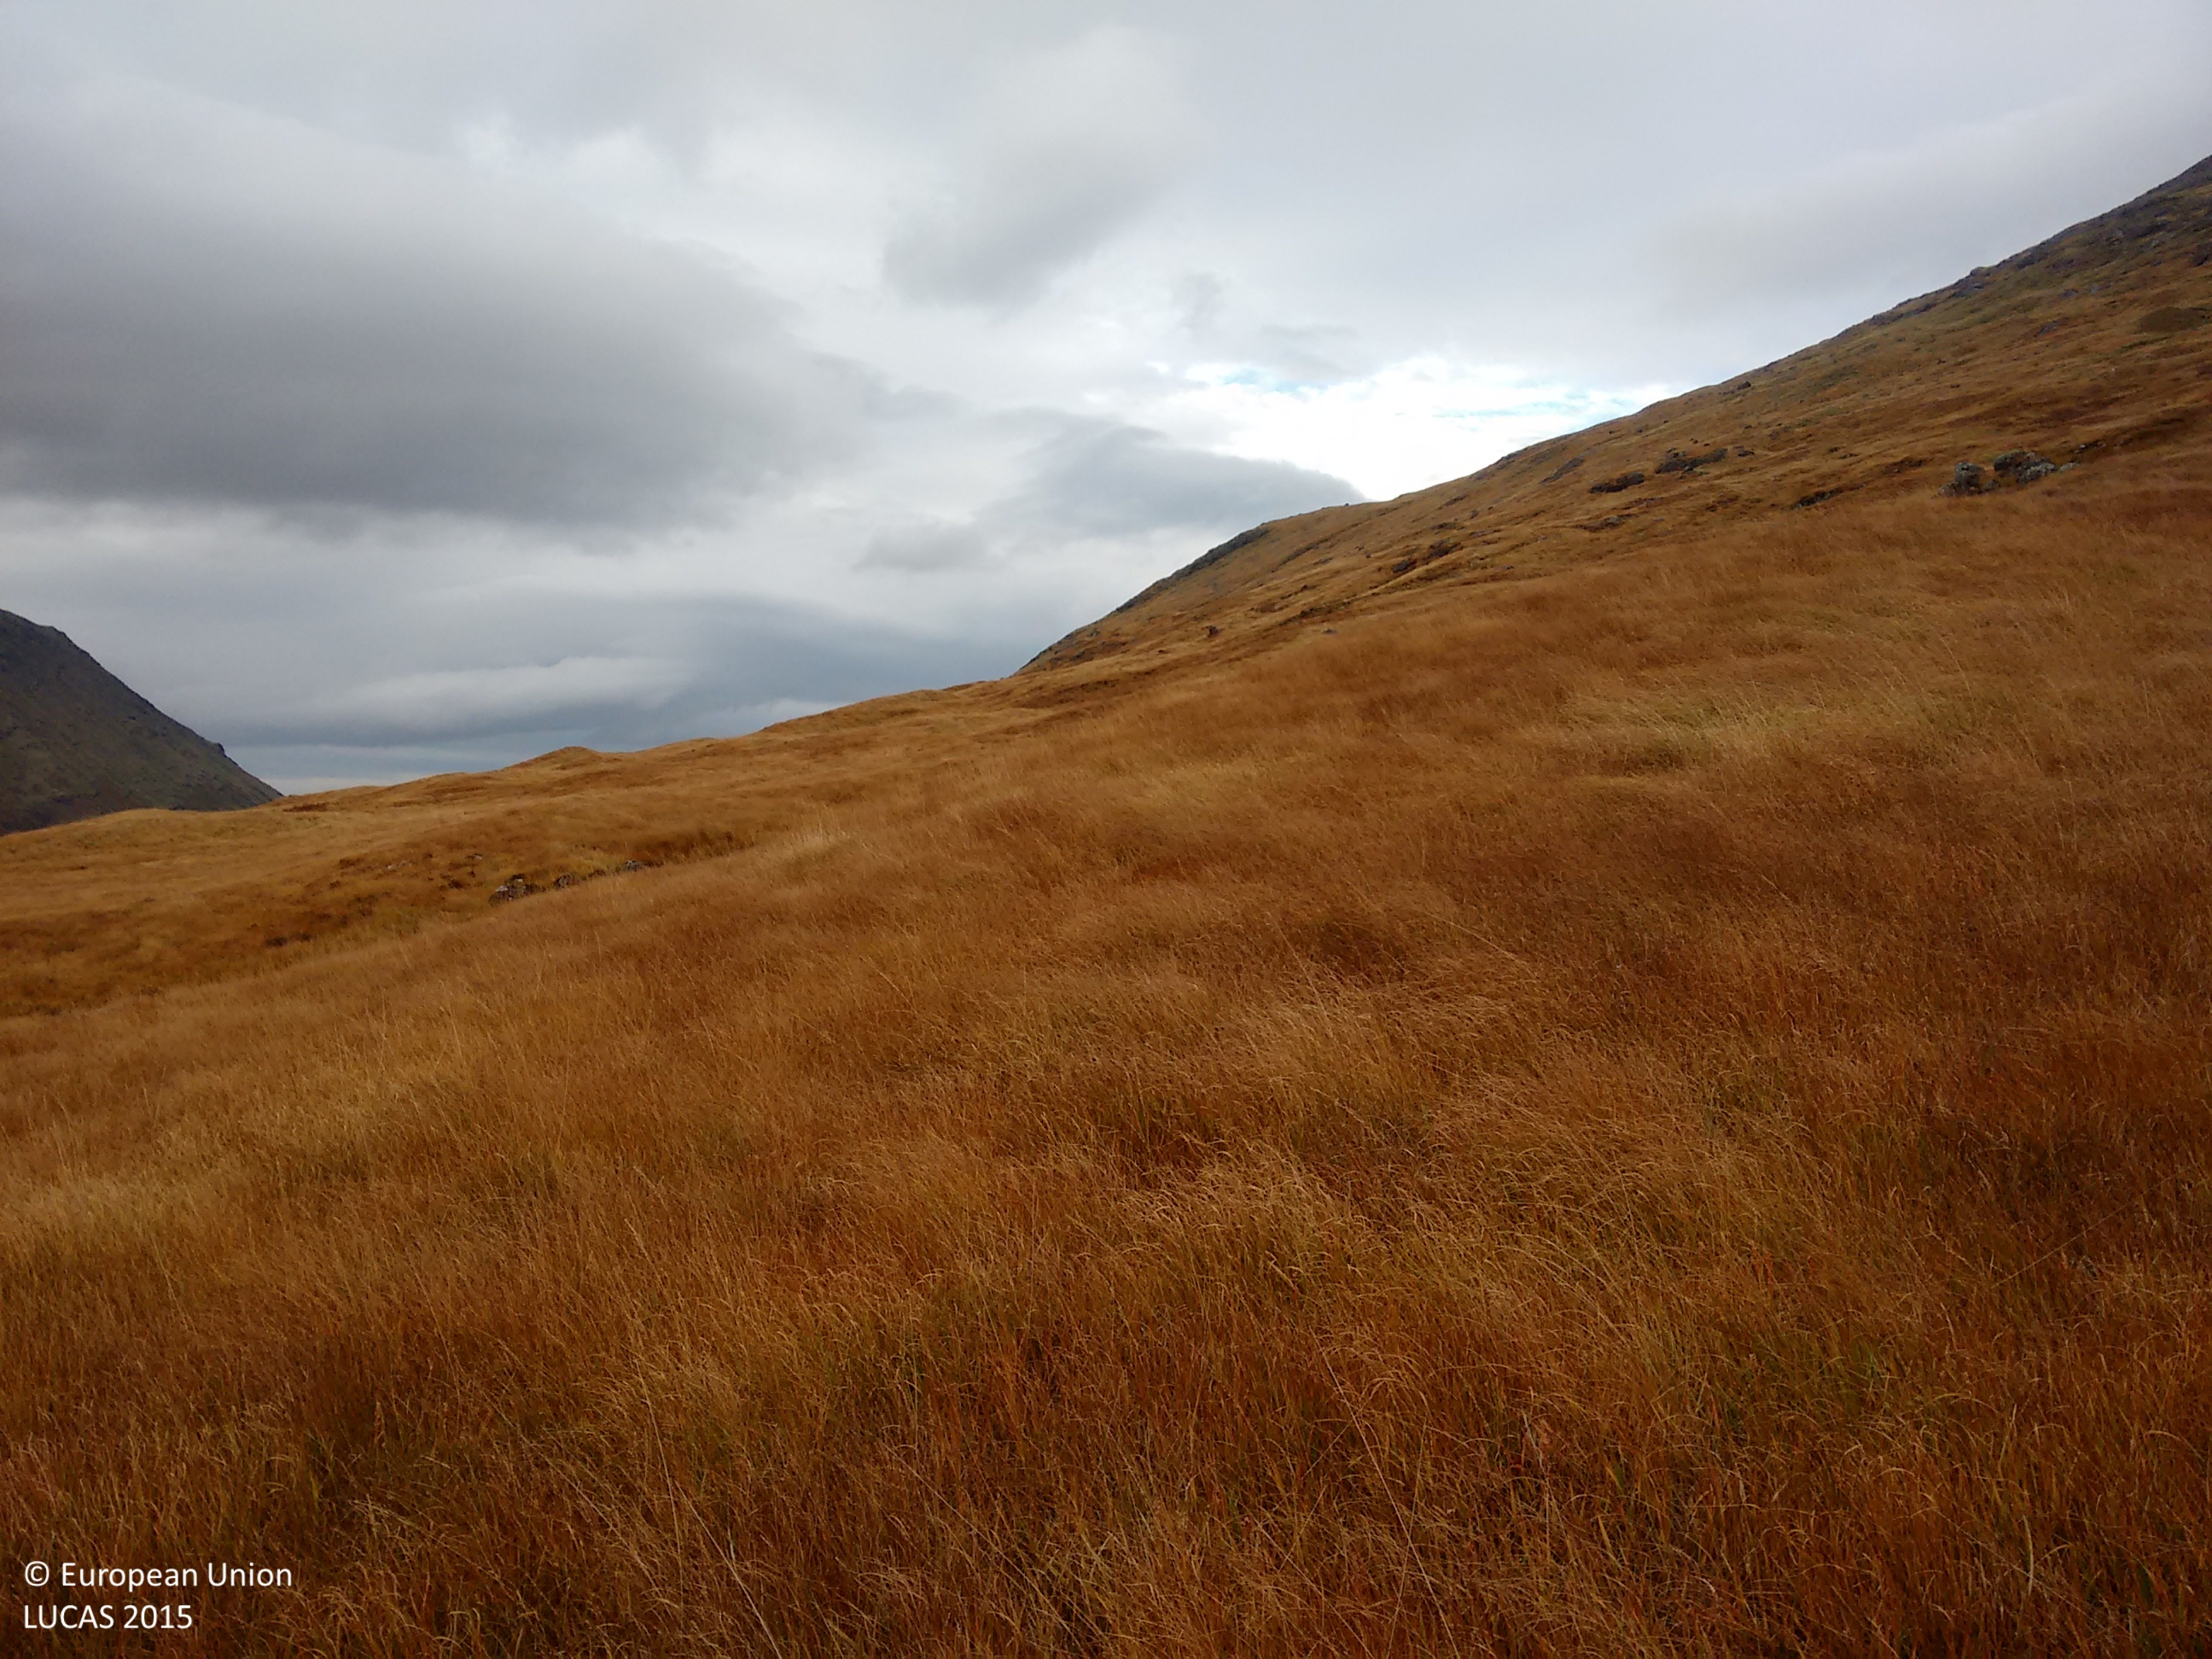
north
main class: Grassland
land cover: Grassland without tree/shrub cover
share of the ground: > 75 %
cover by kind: herbaceous plants 100 %
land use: Semi-natural and natural areas not in use
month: October
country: GB
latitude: 56.4292
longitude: -5.8087
